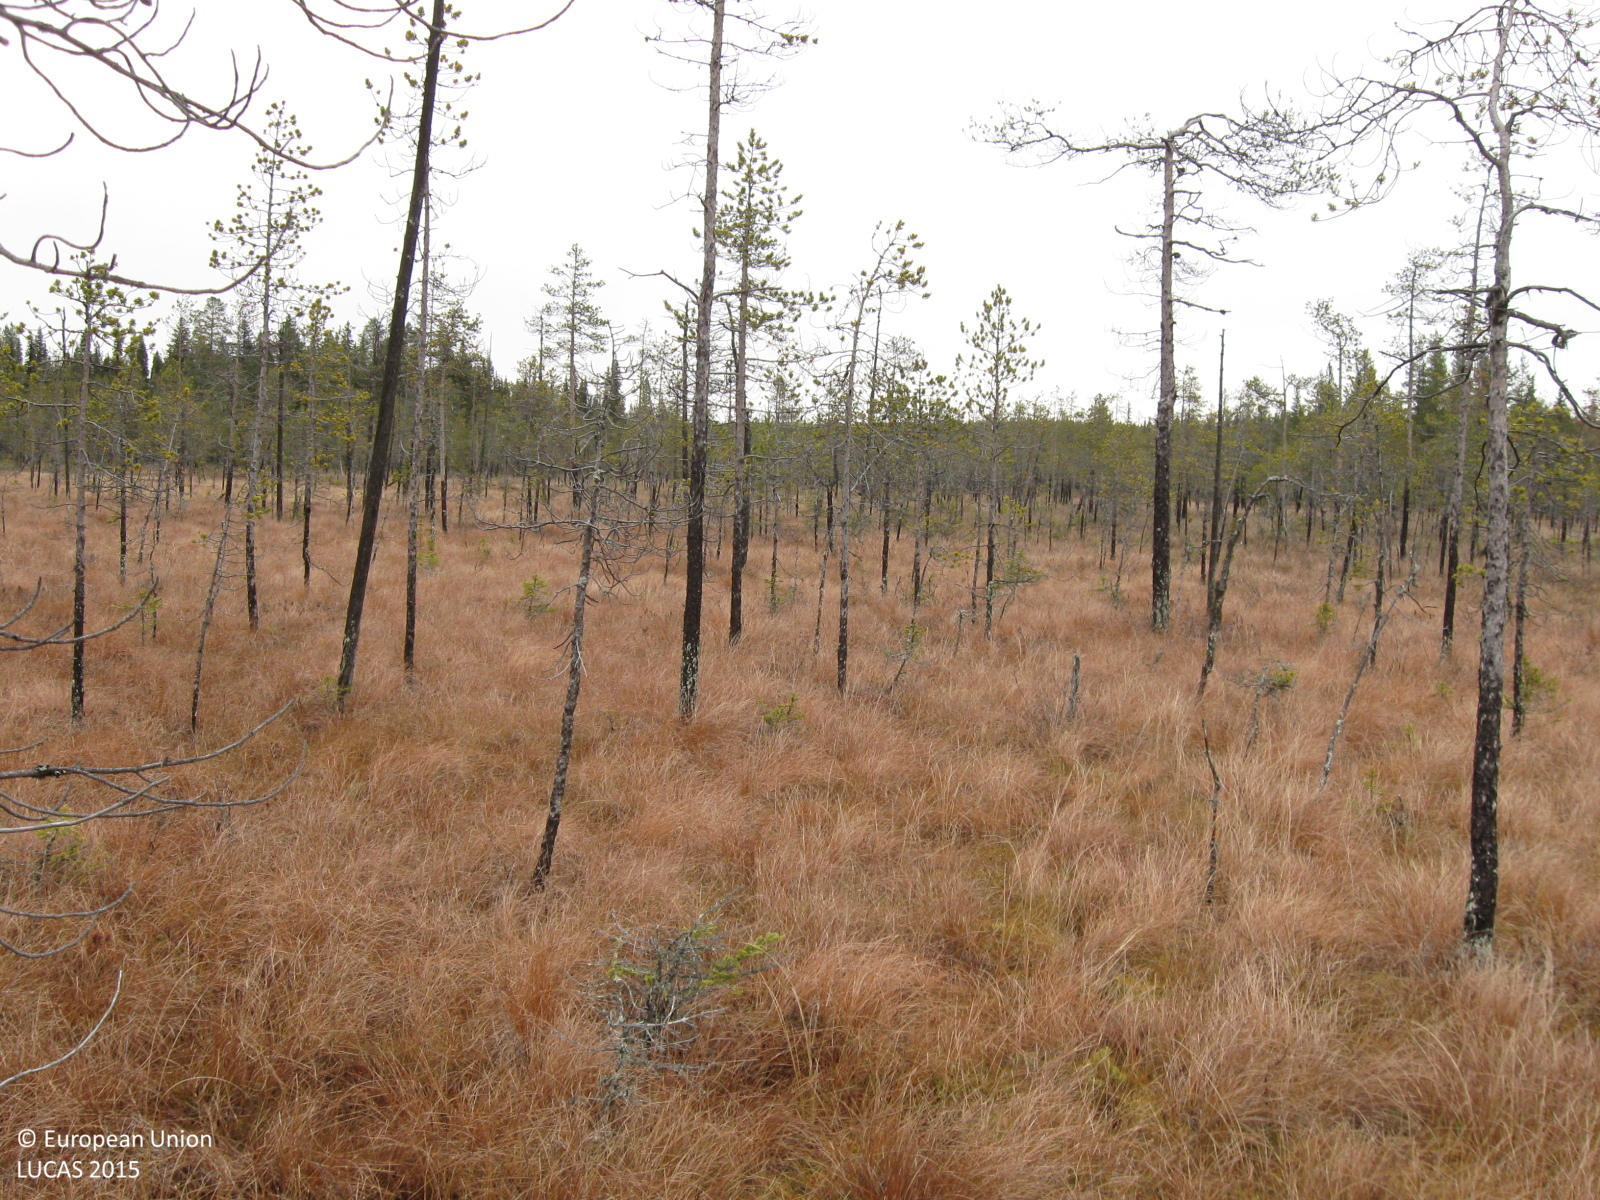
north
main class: Woodland
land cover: Pine dominated coniferous woodland
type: mire and swamp forests
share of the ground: 25 - 50 %
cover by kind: herbaceous plants 60 %, coniferous forest trees 25 %, lichens and mosses 10 %, shrubs 5 %
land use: Semi-natural and natural areas not in use
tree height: < 5 m
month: October
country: SE
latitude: 66.6479
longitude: 21.8326
